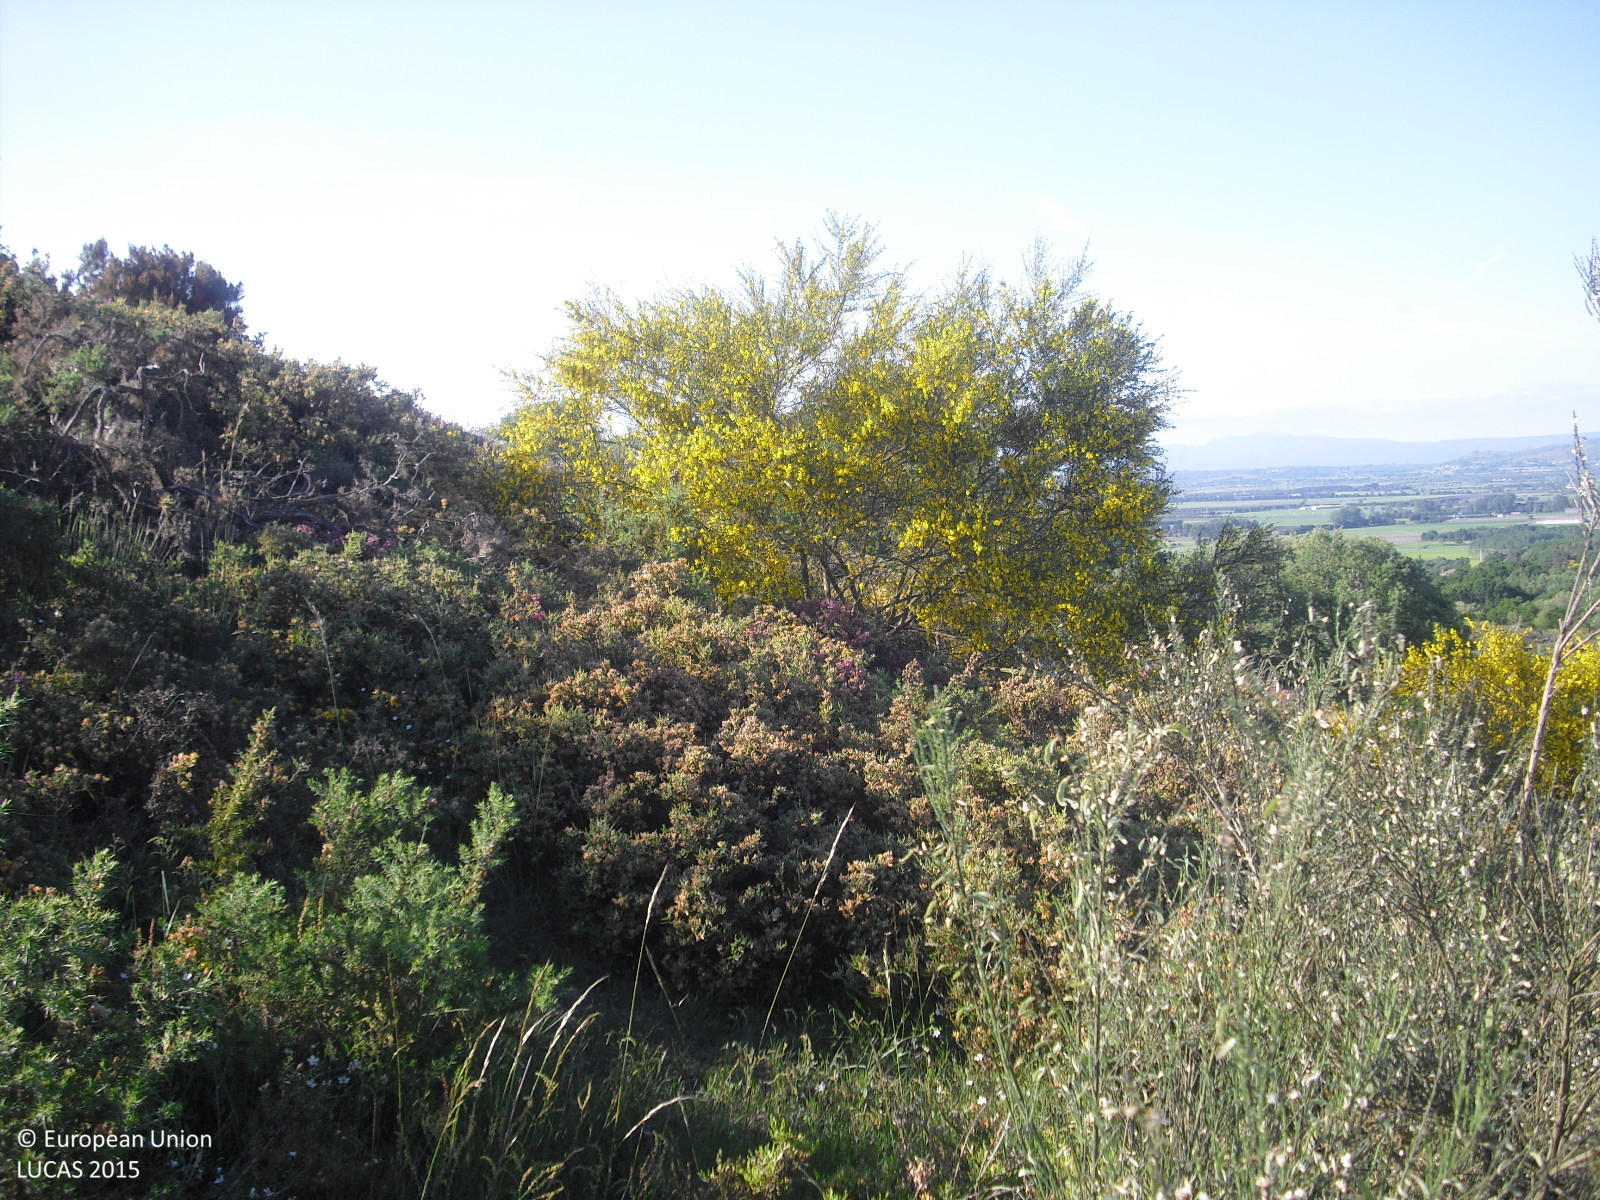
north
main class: Shrubland
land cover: Shrubland with sparse tree cover
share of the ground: > 75 %
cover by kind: shrubs 85 %, consolidated bare surface 10 %, broadleaved forest trees 5 %
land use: Semi-natural and natural areas not in use
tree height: > 5 m
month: May
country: ES
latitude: 42.0799
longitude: -7.6805
